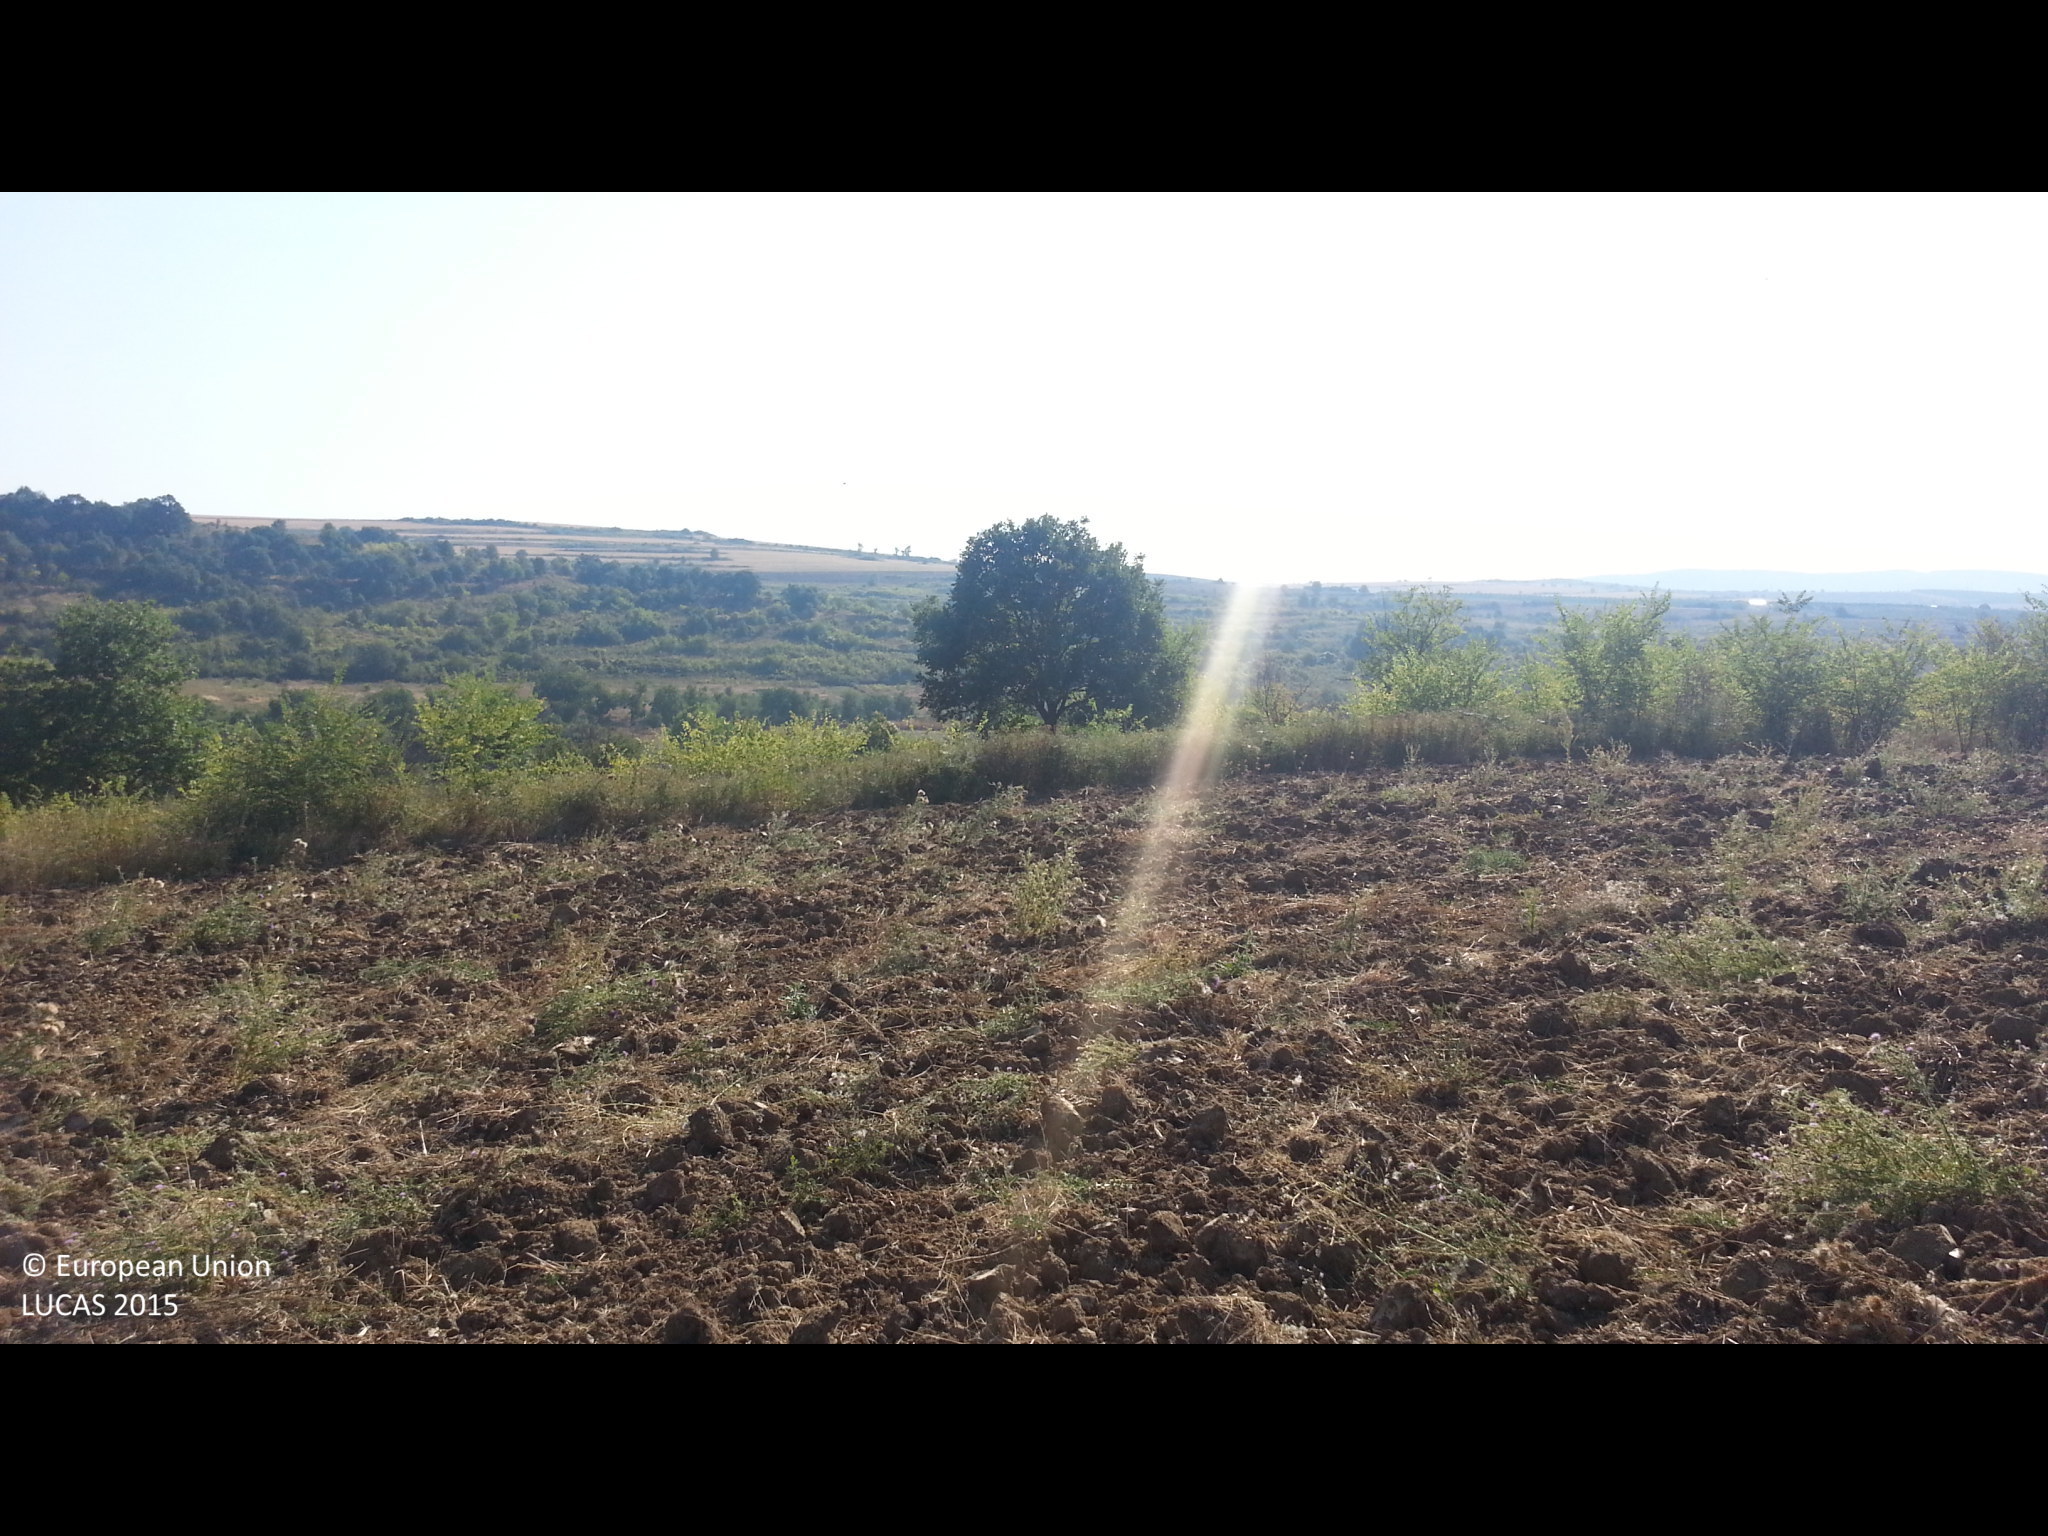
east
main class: Cropland
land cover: Common wheat
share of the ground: < 10 %
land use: Agriculture (excluding fallow land and kitchen gardens)
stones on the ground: 10 - 25 %
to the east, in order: Common wheat; Shrubland without tree cover; Grassland without tree/shrub cover; Shrubland with sparse tree cover; Spontaneously vegetated surfaces
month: September
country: BG
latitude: 42.3449
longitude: 22.9779
